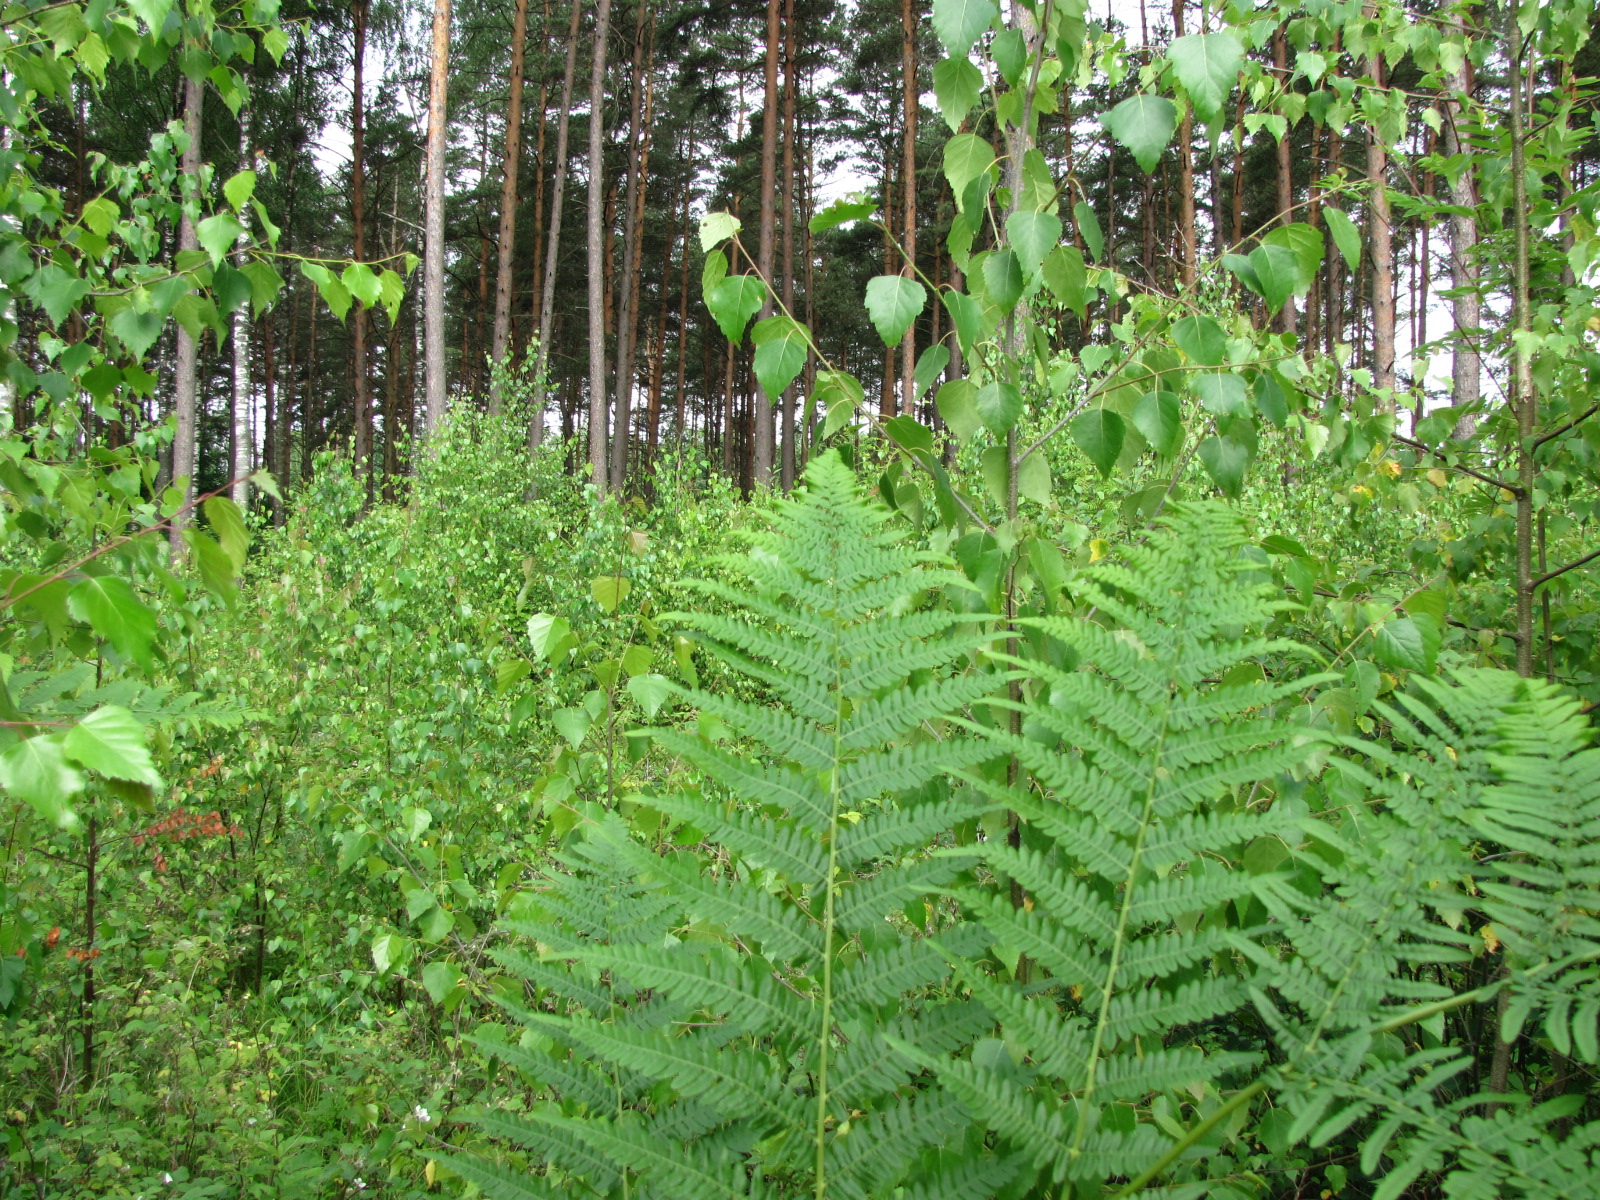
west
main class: Woodland
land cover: Broadleaved woodland
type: non-riverine alder, birch or aspen forest
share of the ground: > 75 %
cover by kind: broadleaved forest trees 95 %, herbaceous plants 5 %
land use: Forestry
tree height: < 5 m
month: June
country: LV
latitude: 56.8833
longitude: 23.9499
